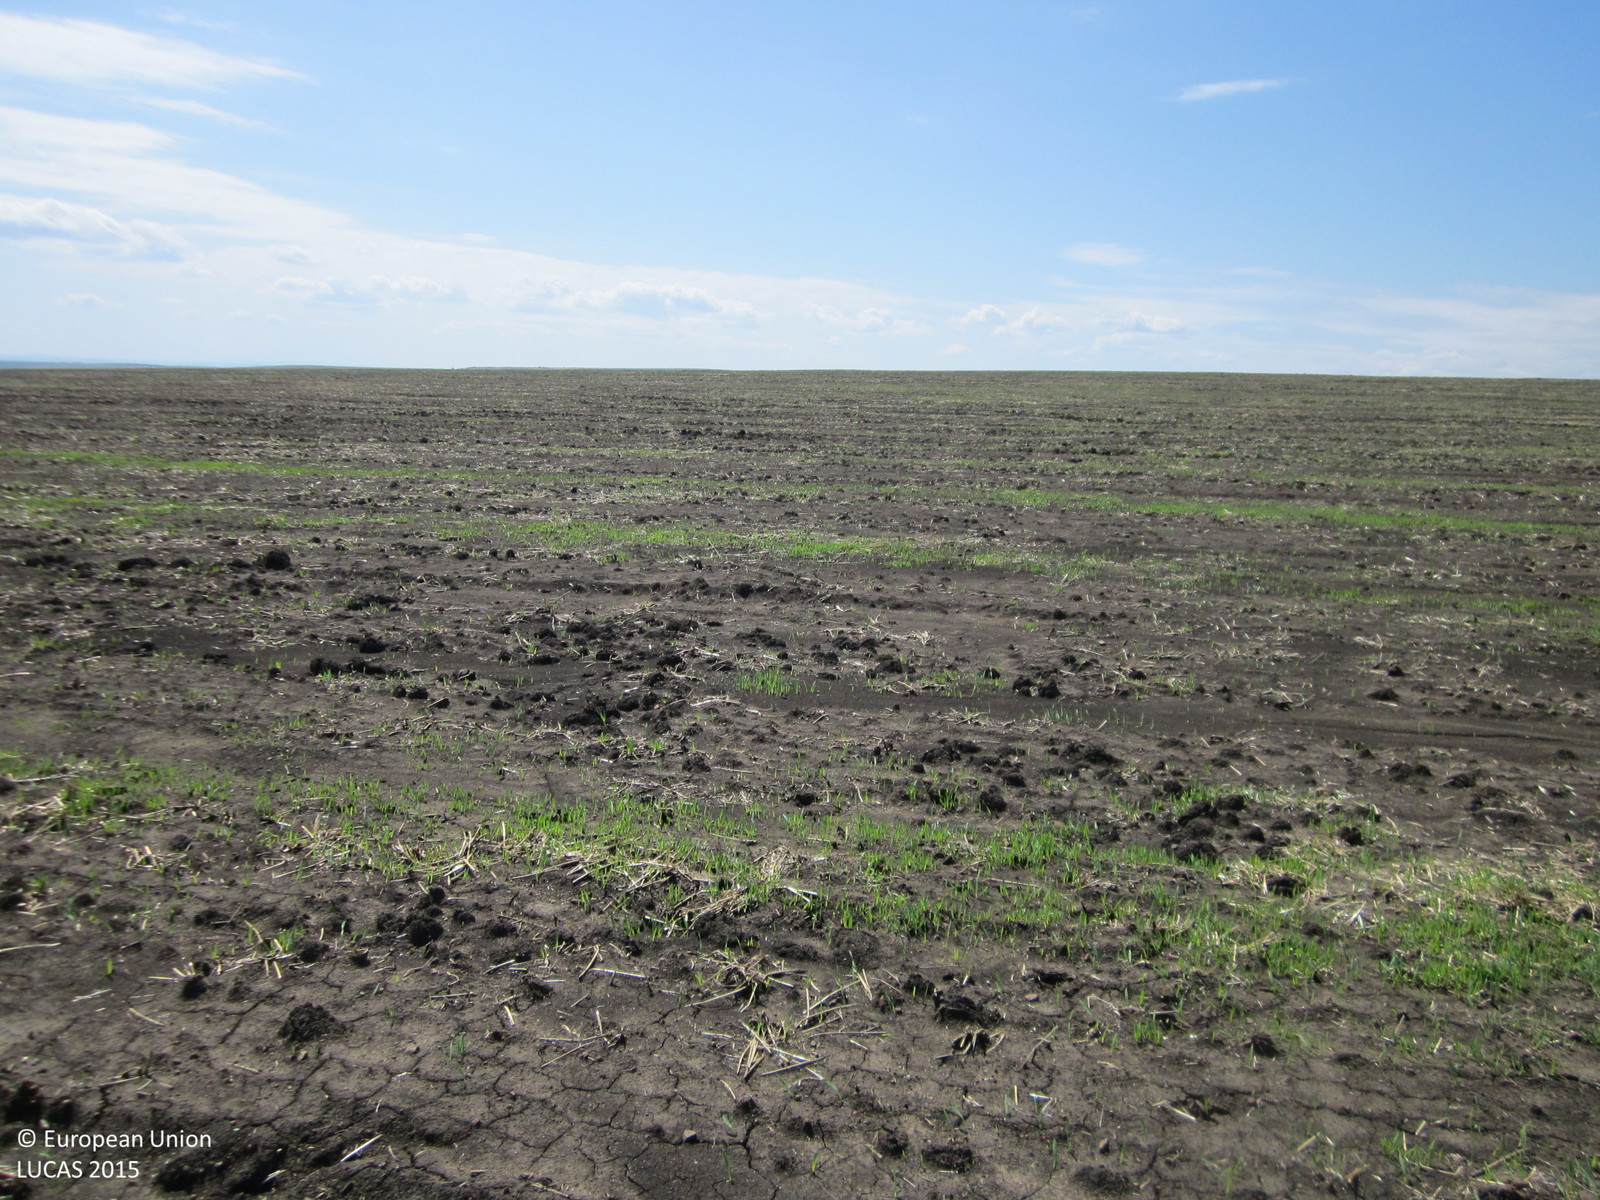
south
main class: Cropland
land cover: Common wheat
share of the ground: < 10 %
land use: Agriculture (excluding fallow land and kitchen gardens)
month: August
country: BG
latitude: 42.5925
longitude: 26.9587
